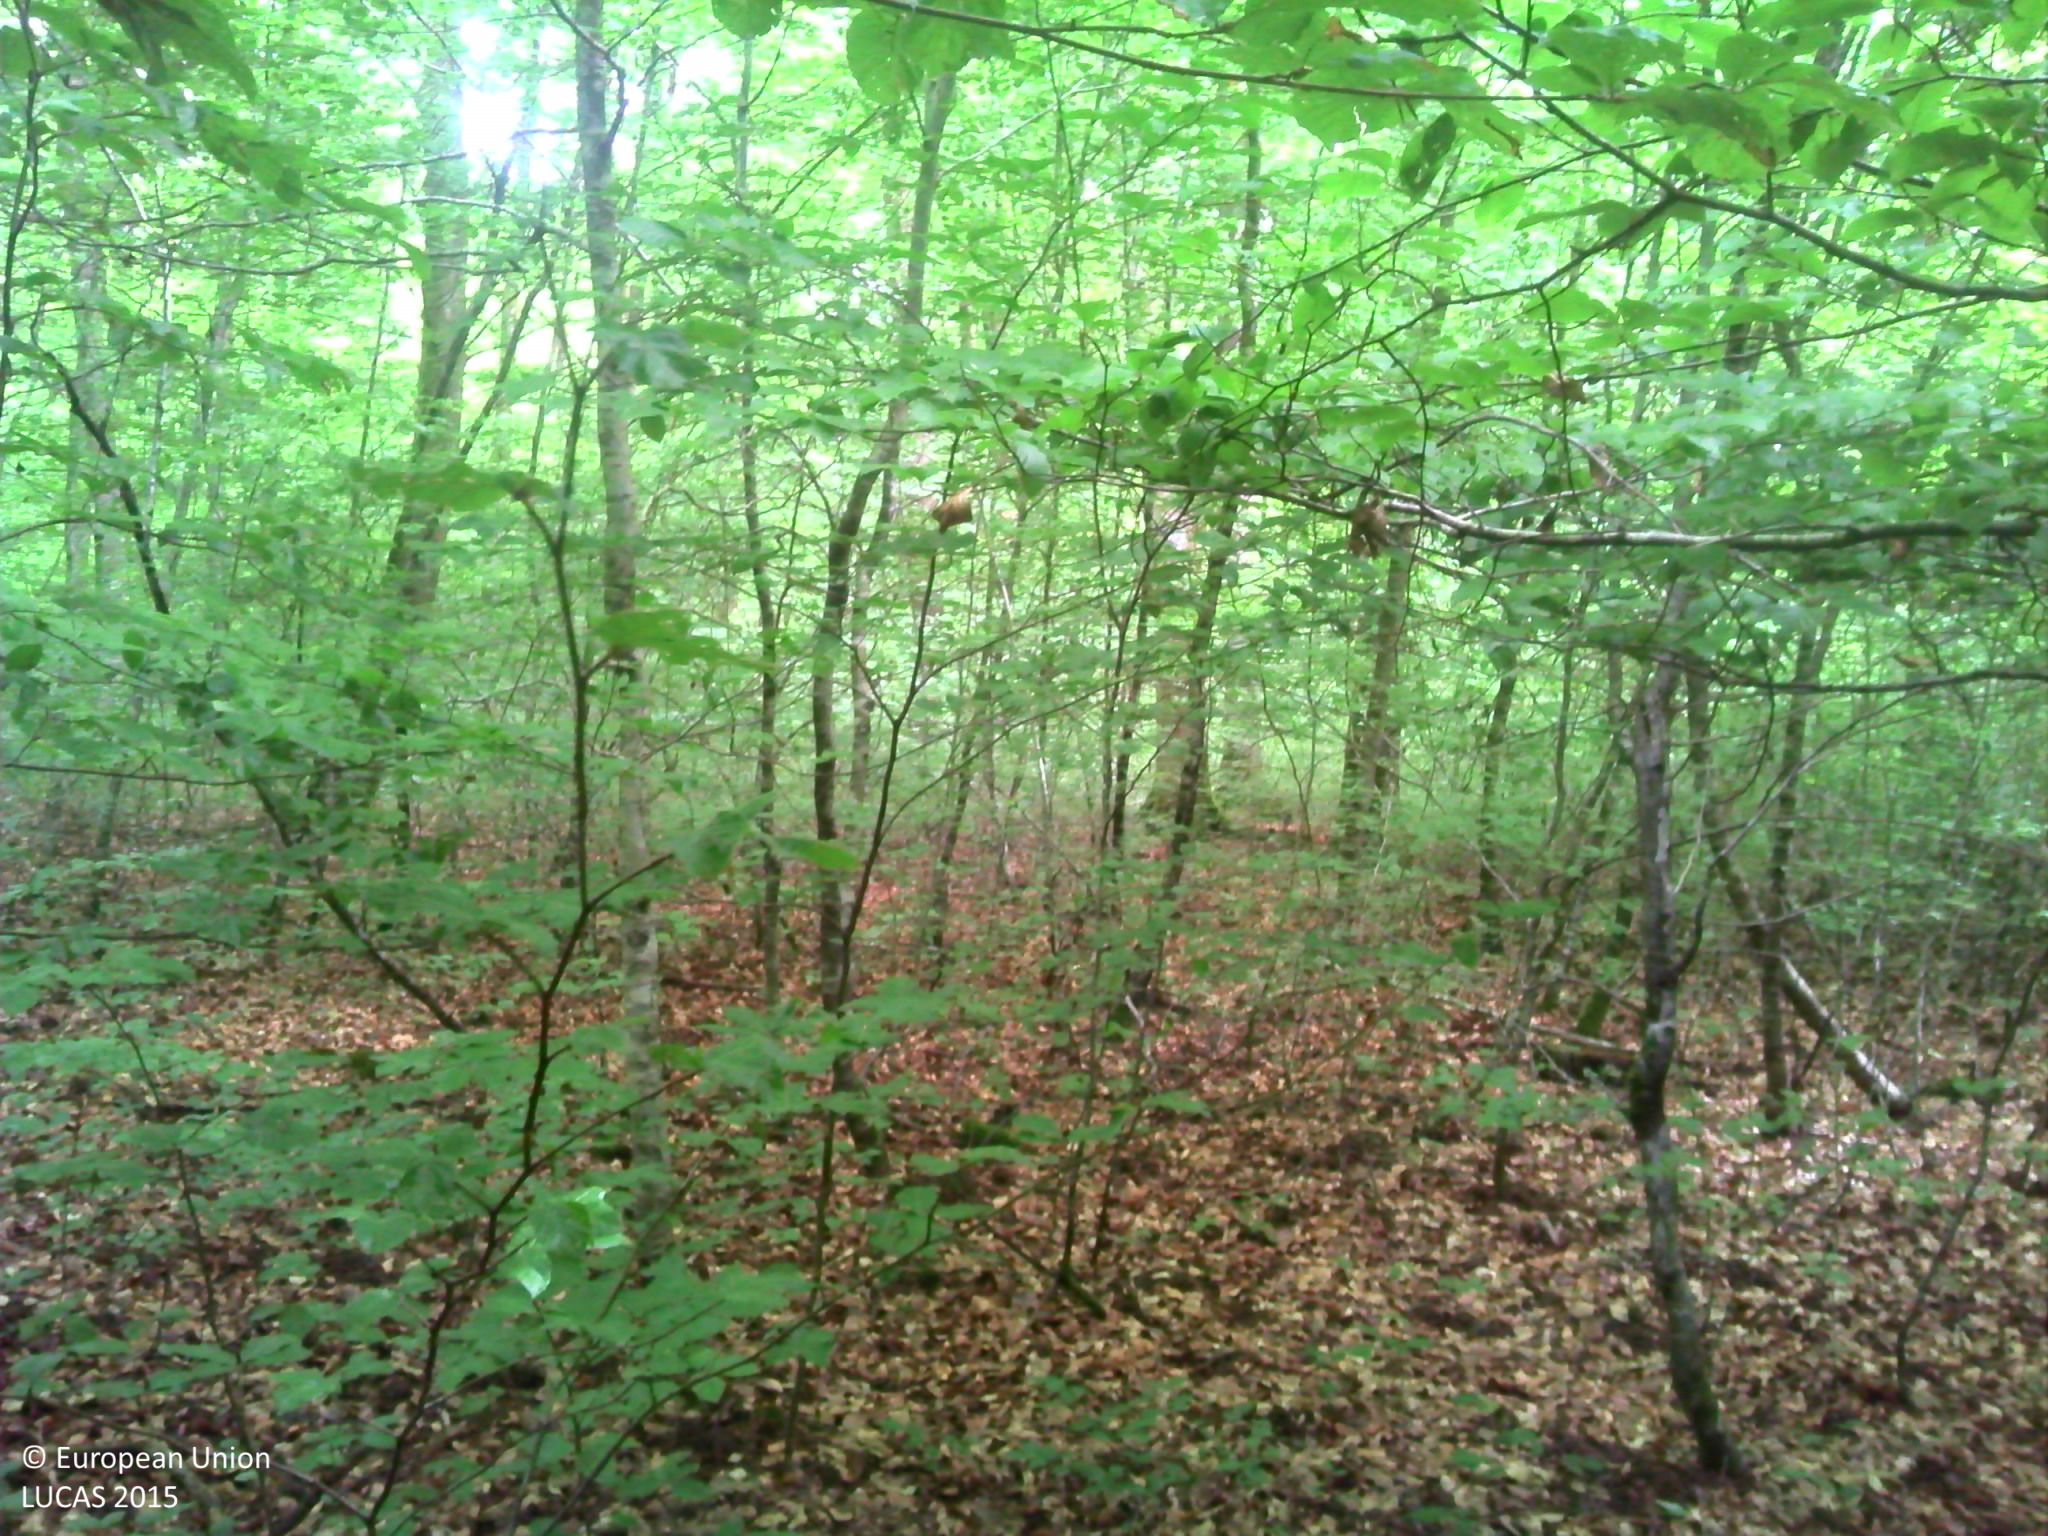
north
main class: Woodland
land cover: Broadleaved woodland
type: beech forest
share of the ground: > 75 %
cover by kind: broadleaved forest trees 90 %, unconsolidated bare surface 10 %
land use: Forestry
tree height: > 5 m
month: June
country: FR
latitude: 47.8201
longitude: 6.3281
